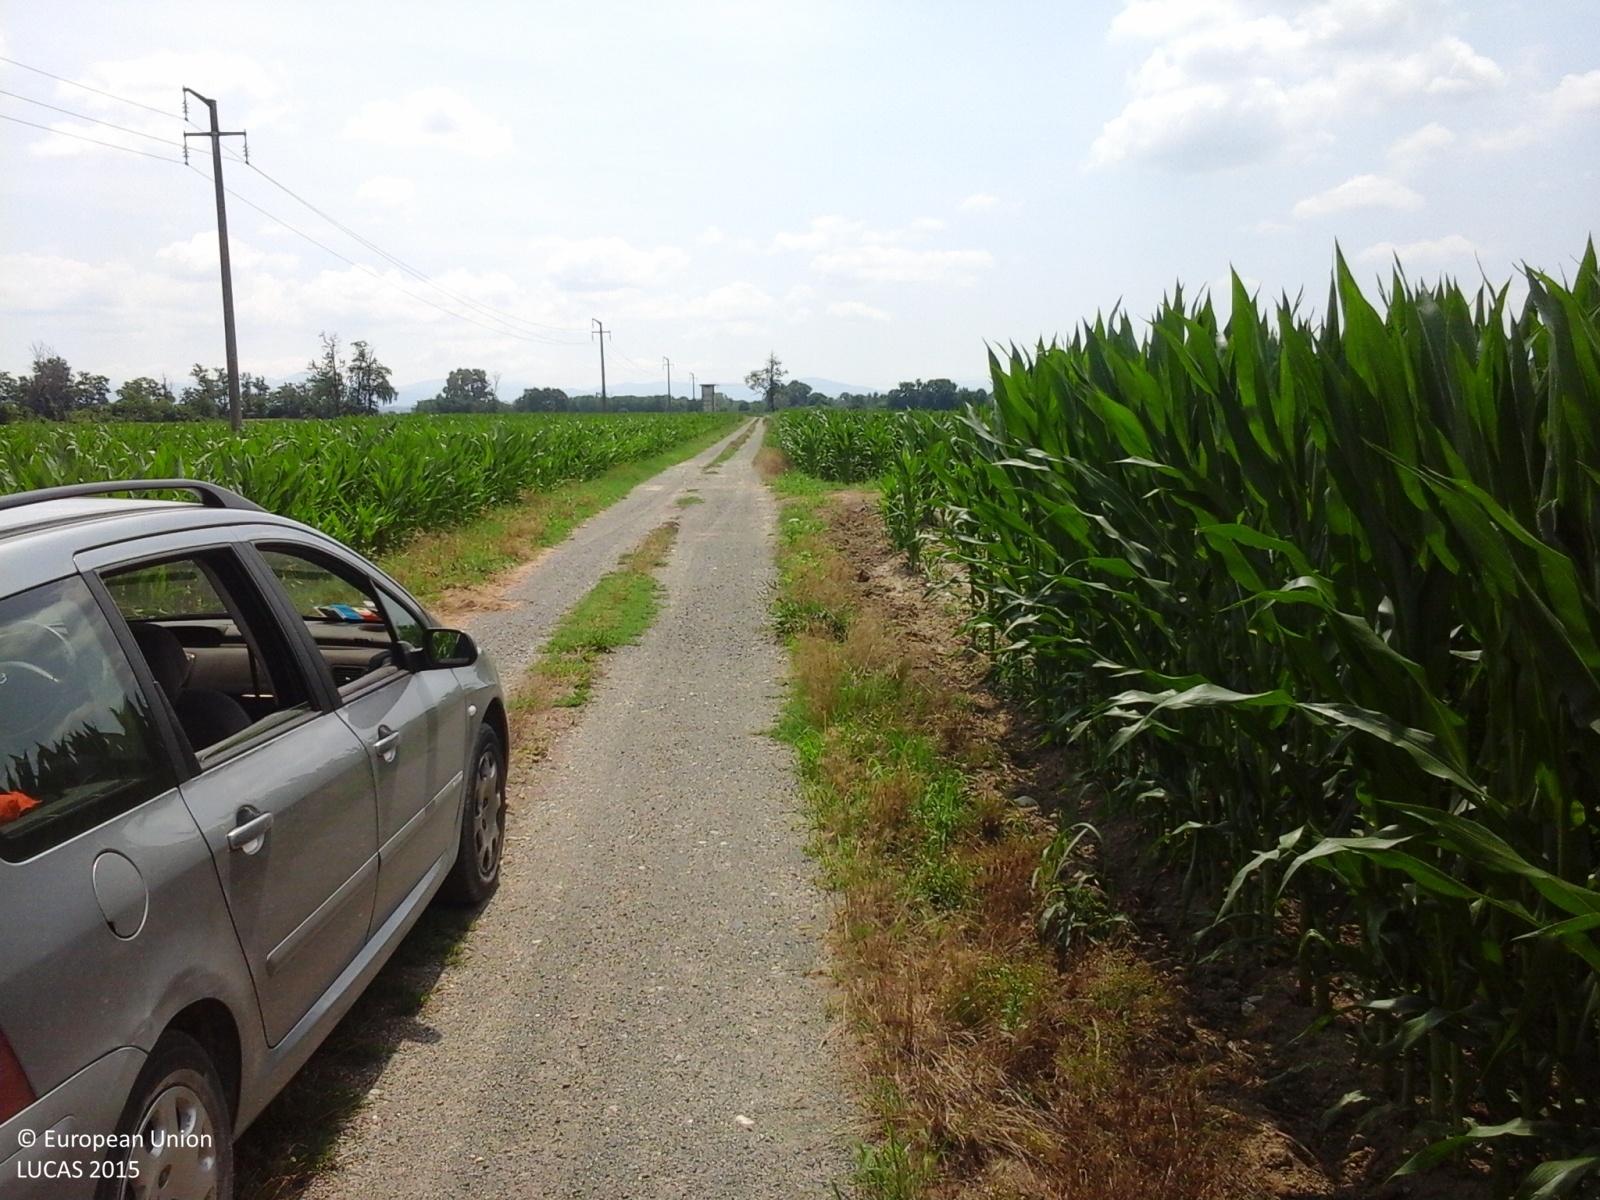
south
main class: Cropland
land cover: Maize
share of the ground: > 75 %
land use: Agriculture (excluding fallow land and kitchen gardens)
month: June
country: IT
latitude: 44.8107
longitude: 8.6498
